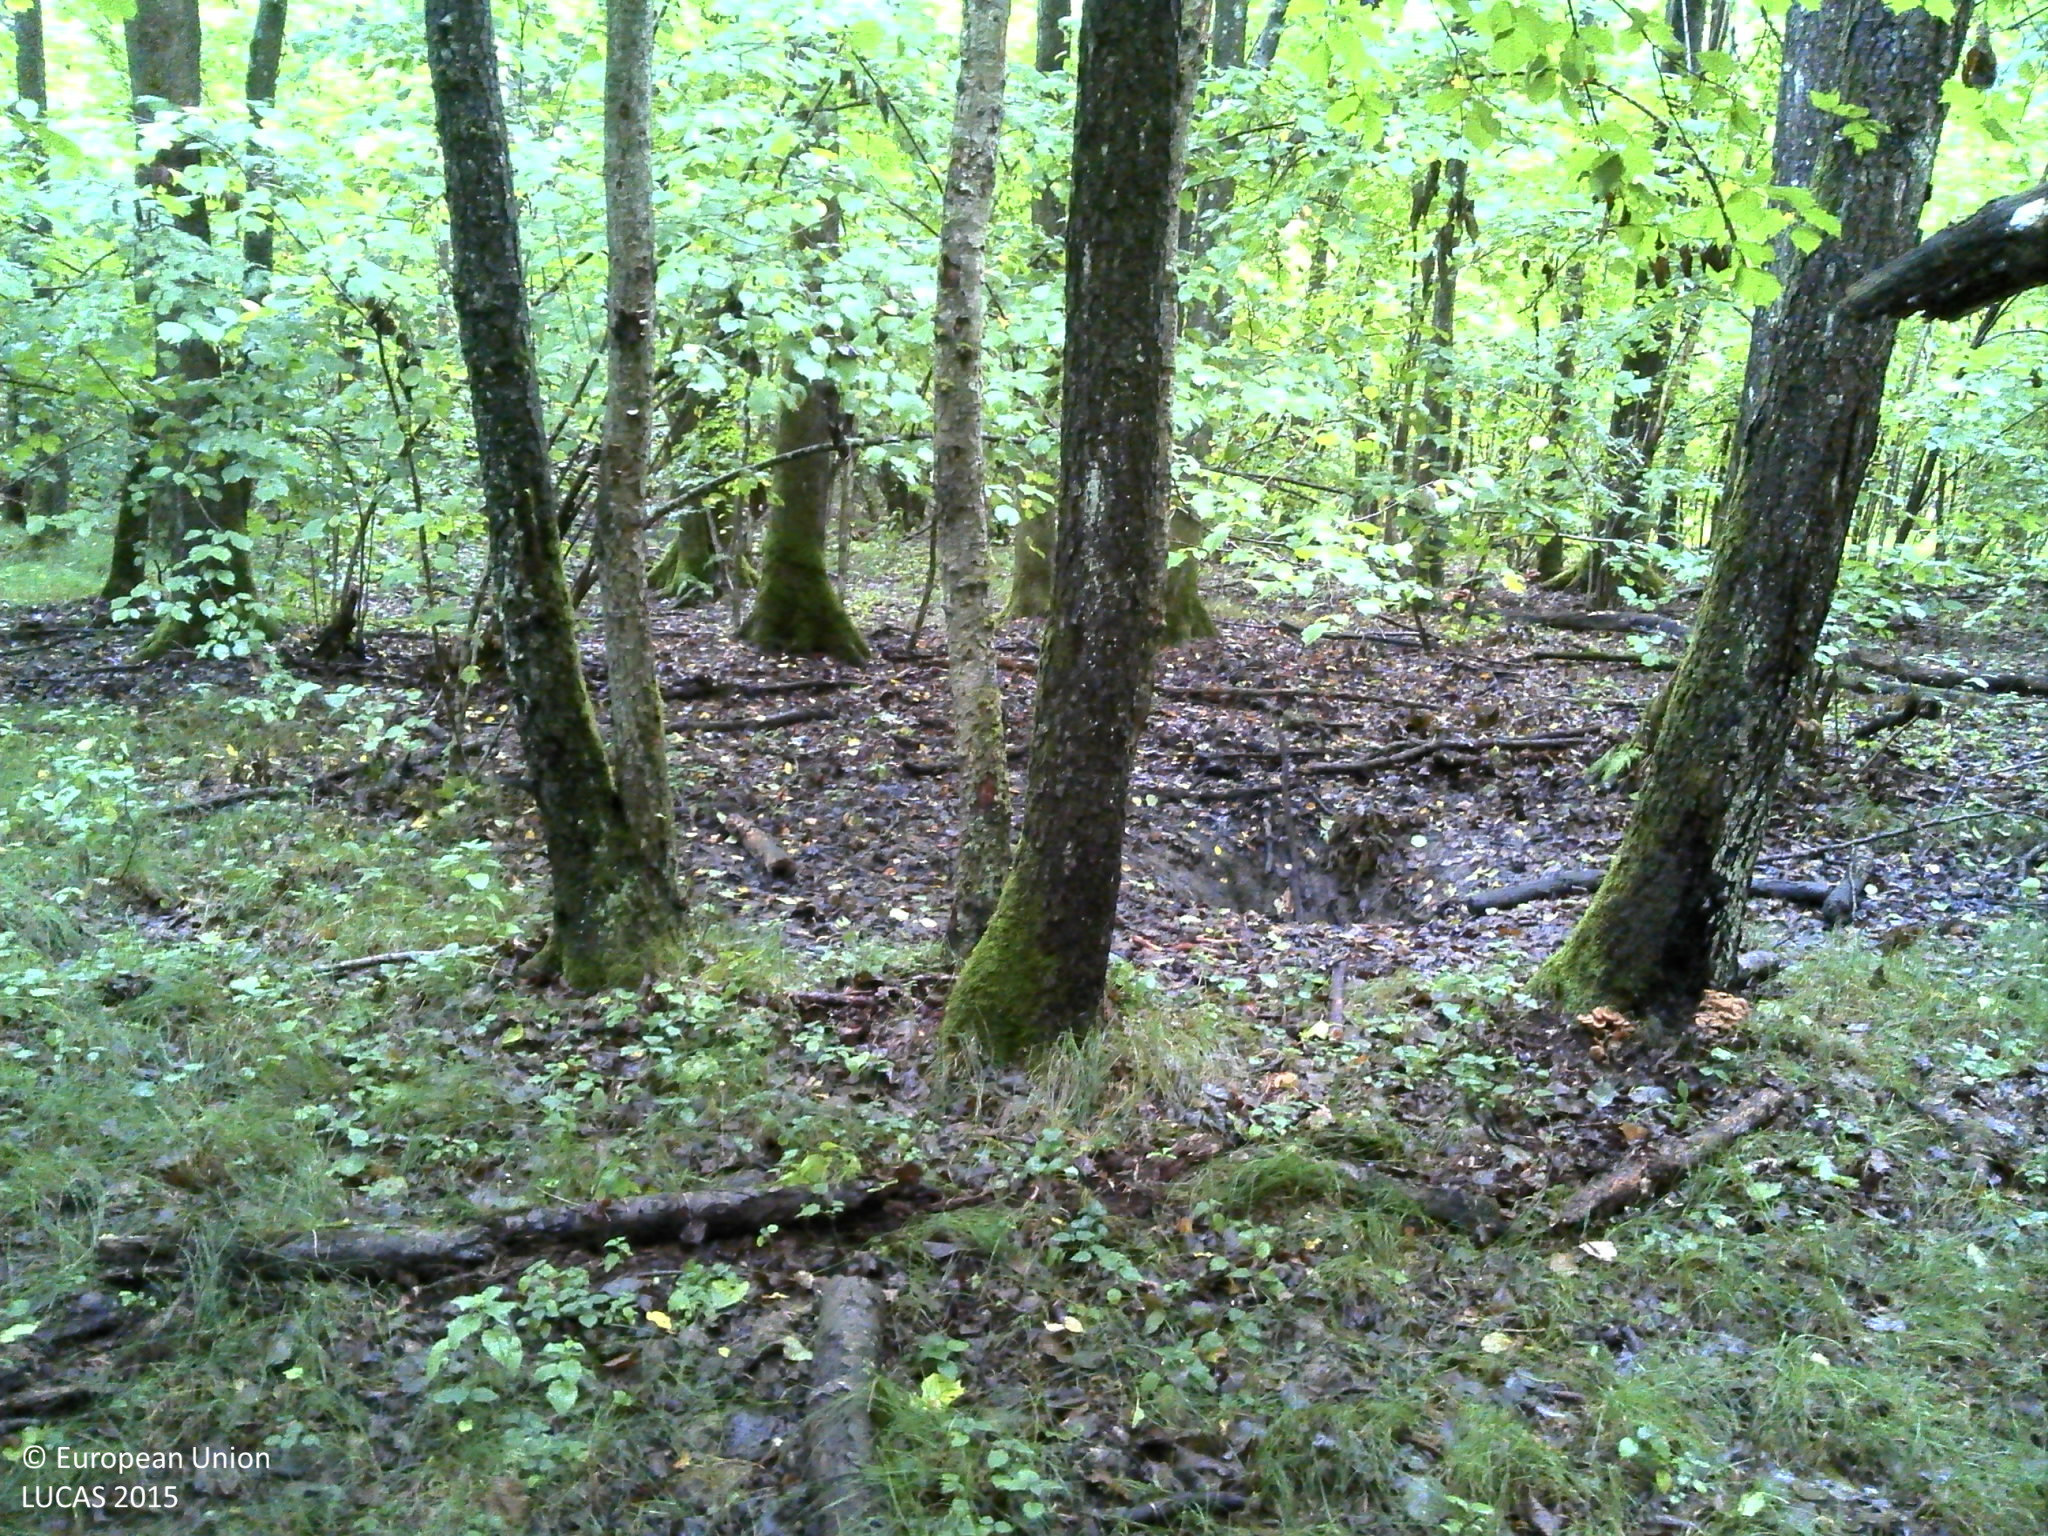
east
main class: Woodland
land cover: Broadleaved woodland
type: mesophytic deciduous forest
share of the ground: > 75 %
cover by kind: broadleaved forest trees 100 %
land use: Forestry
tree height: > 5 m
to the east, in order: Broadleaved woodland
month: August
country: HR
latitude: 45.5700
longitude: 15.6474
